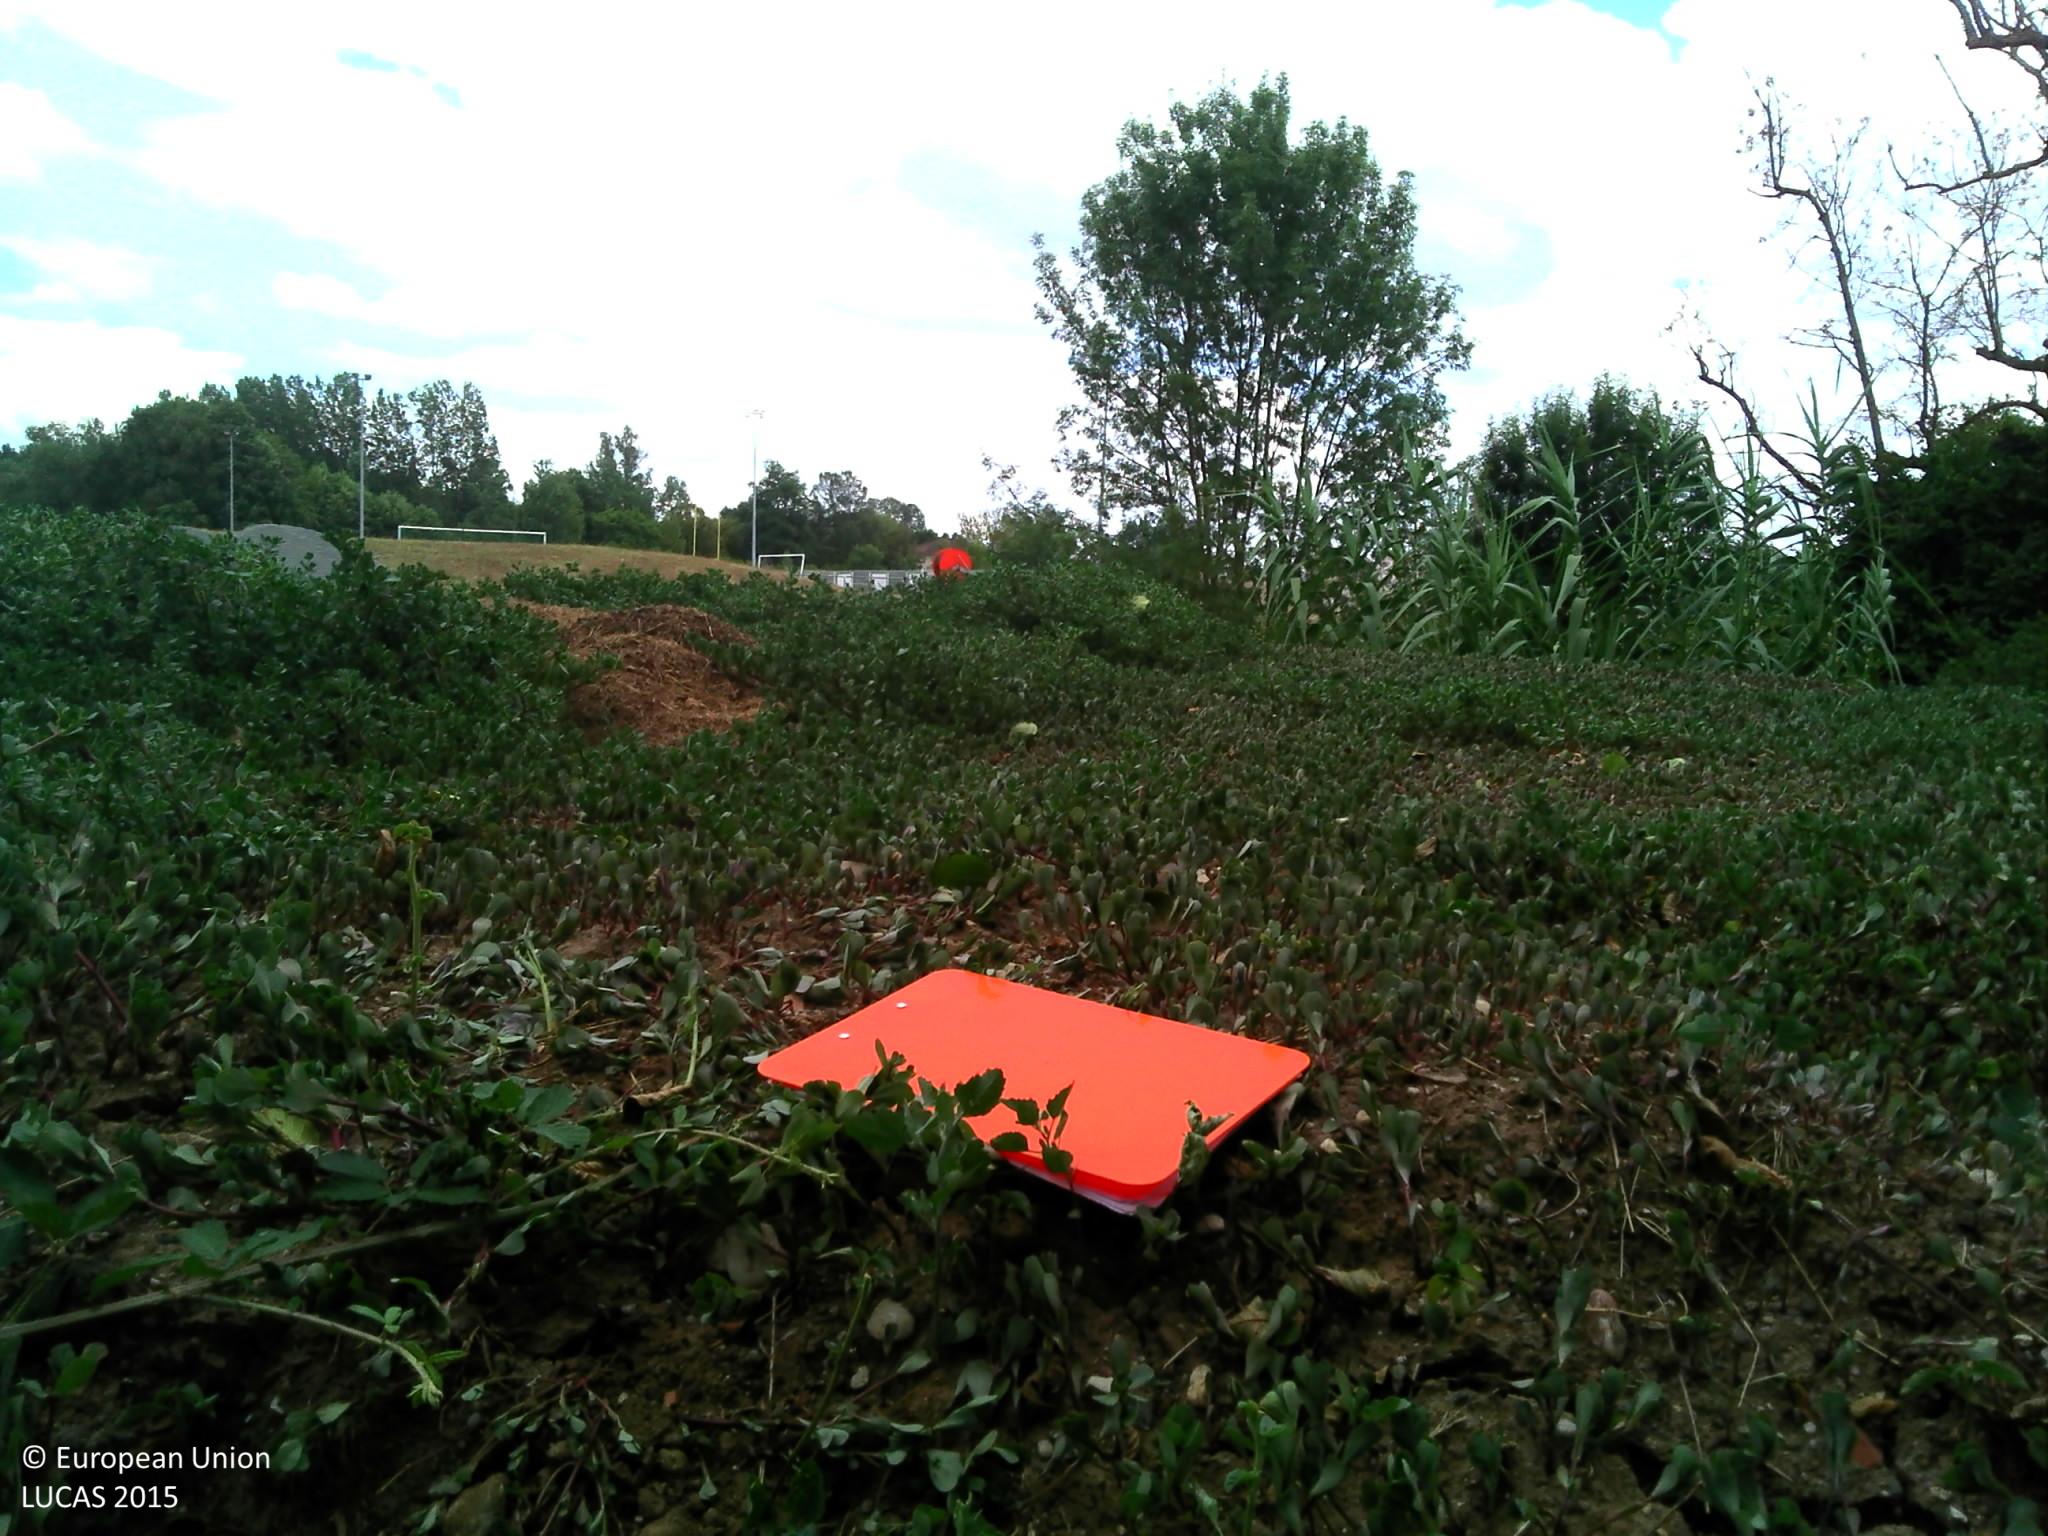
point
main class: Grassland
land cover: Spontaneously vegetated surfaces
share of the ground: > 75 %
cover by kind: unconsolidated bare surface 60 %, herbaceous plants 40 %
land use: Abandoned areas
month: July
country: FR
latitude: 44.4186
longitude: 0.6620
